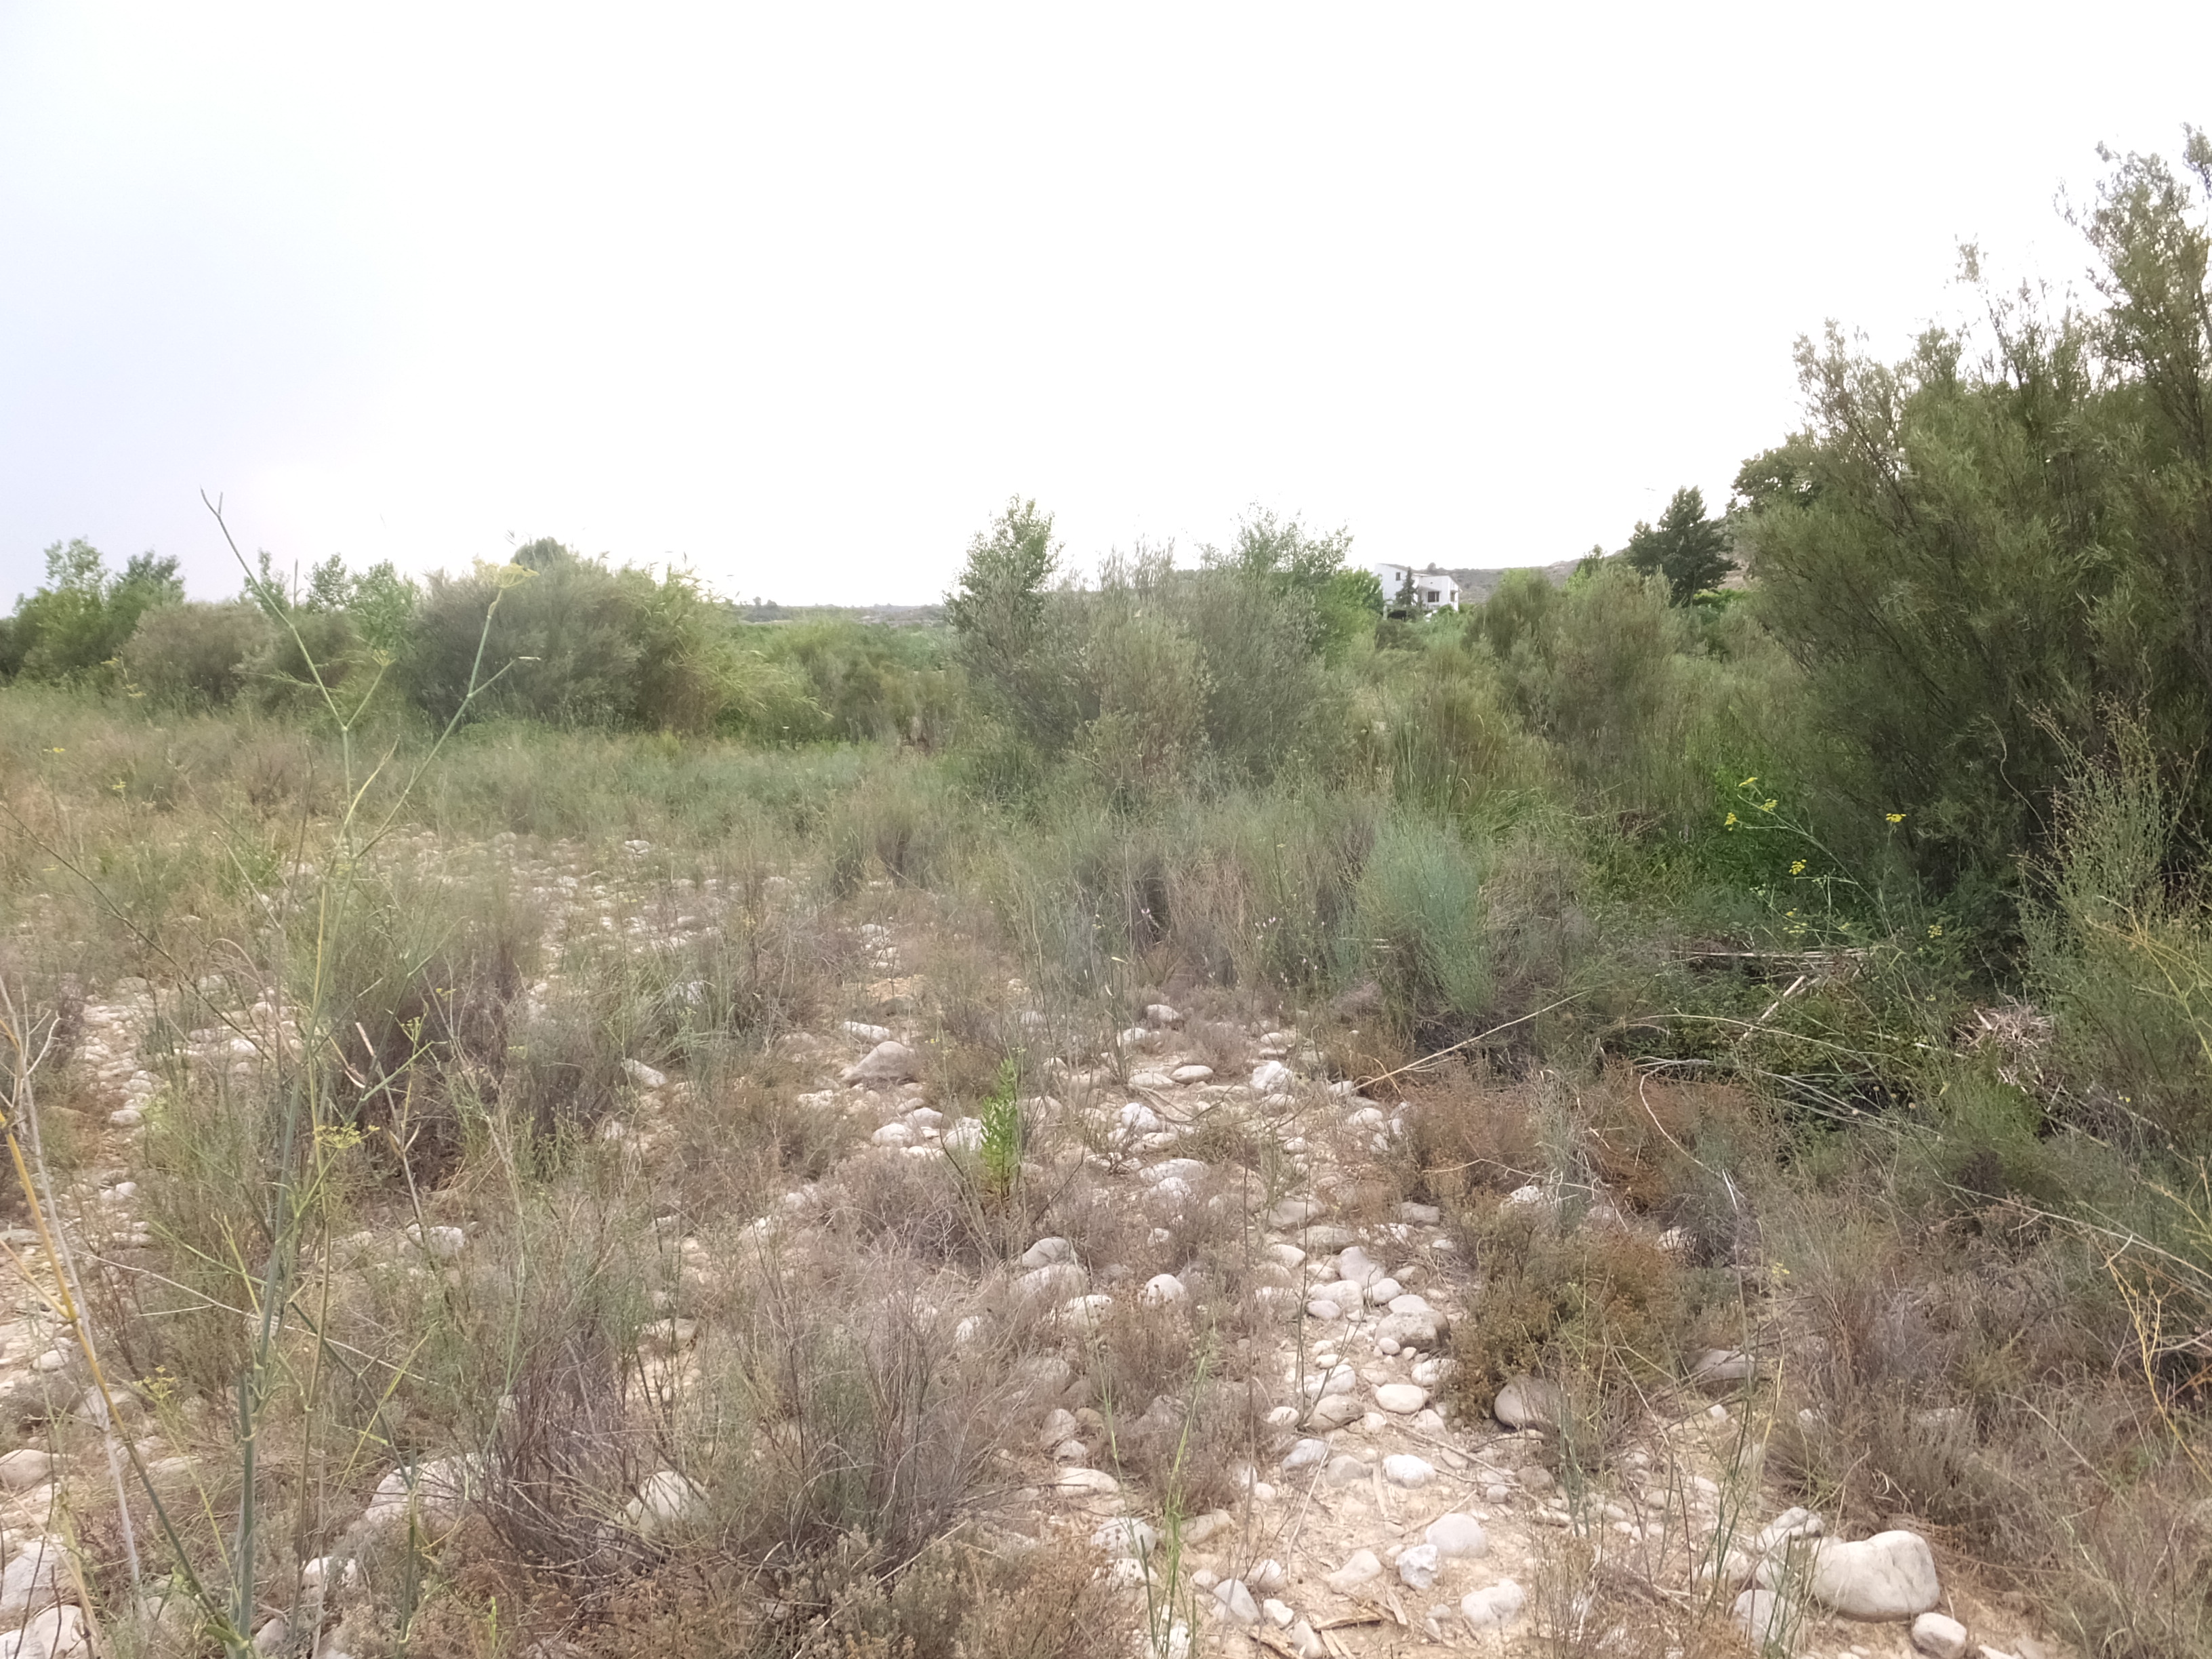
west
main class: Shrubland
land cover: Shrubland with sparse tree cover
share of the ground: > 75 %
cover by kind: shrubs 70 %, herbaceous plants 25 %, broadleaved forest trees 5 %
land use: Semi-natural and natural areas not in use
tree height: > 5 m
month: July
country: ES
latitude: 41.1169
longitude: 0.1403
